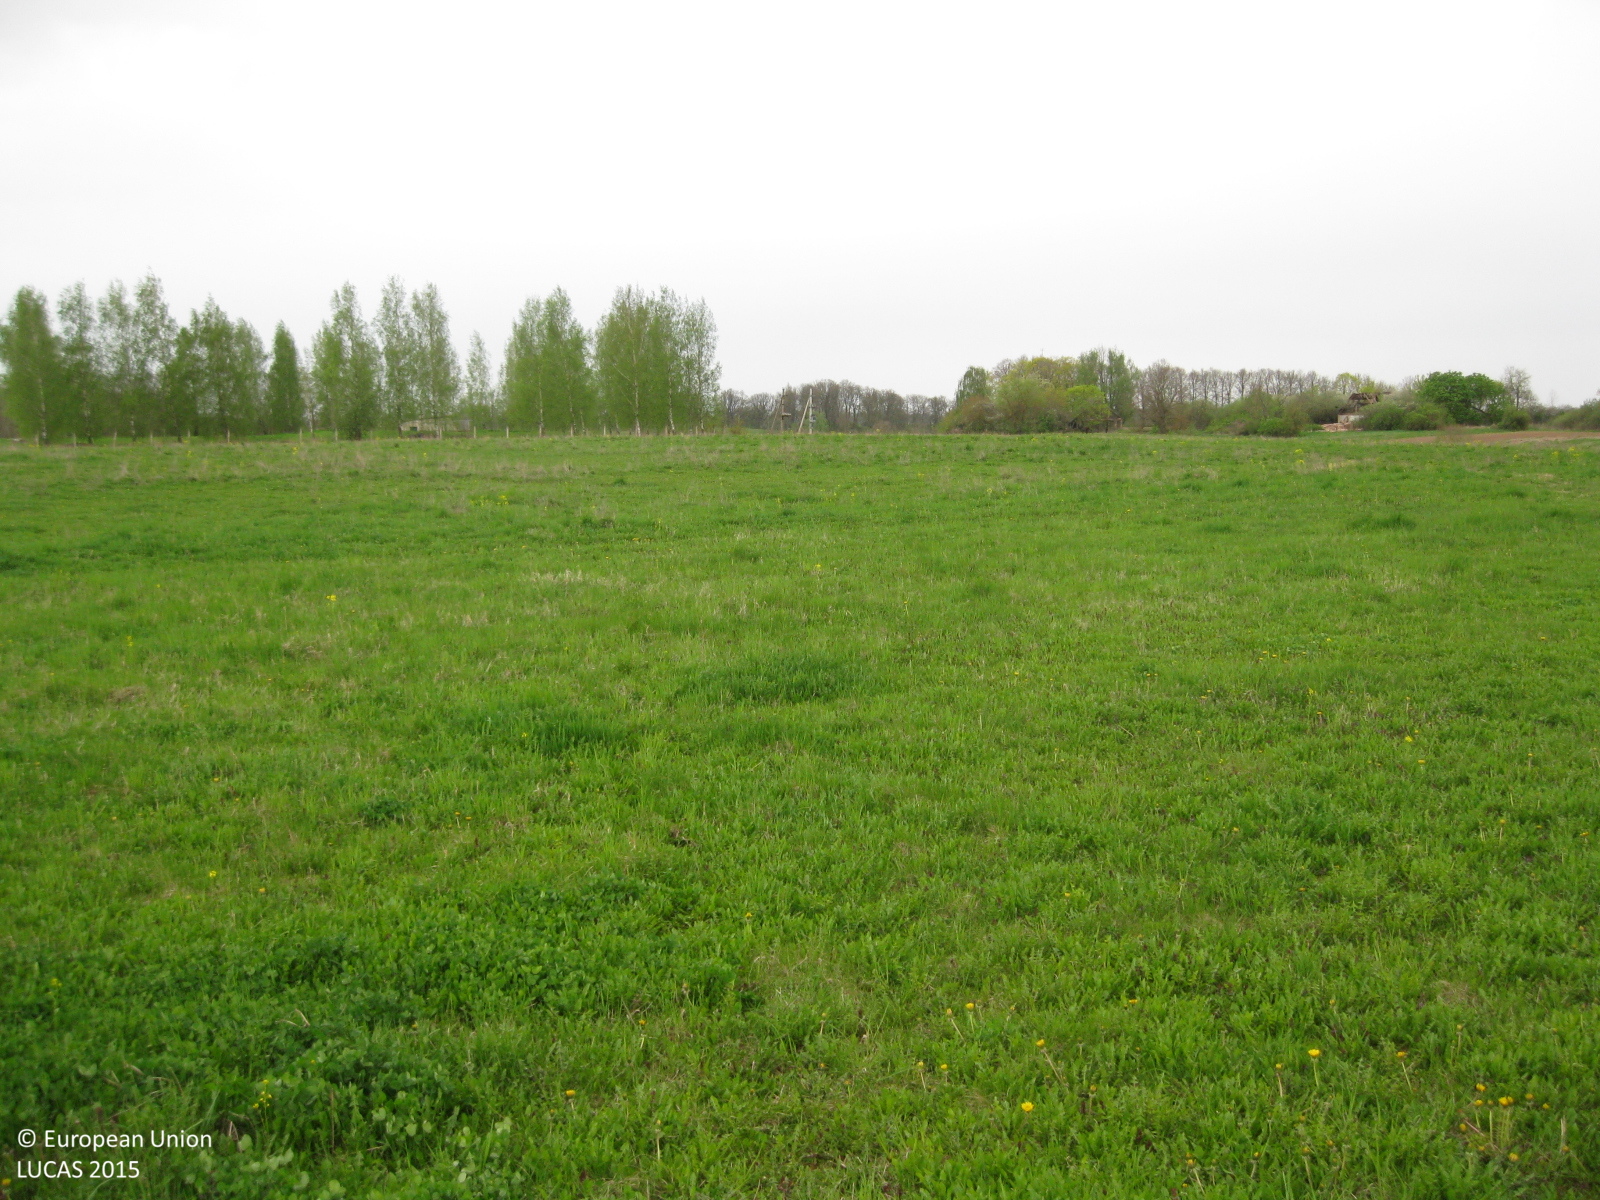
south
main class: Grassland
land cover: Grassland without tree/shrub cover
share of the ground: > 75 %
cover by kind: herbaceous plants 95 %, unconsolidated bare surface 5 %
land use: Agriculture (excluding fallow land and kitchen gardens)
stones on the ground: < 10 %
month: May
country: LT
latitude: 56.1308
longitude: 24.4644
